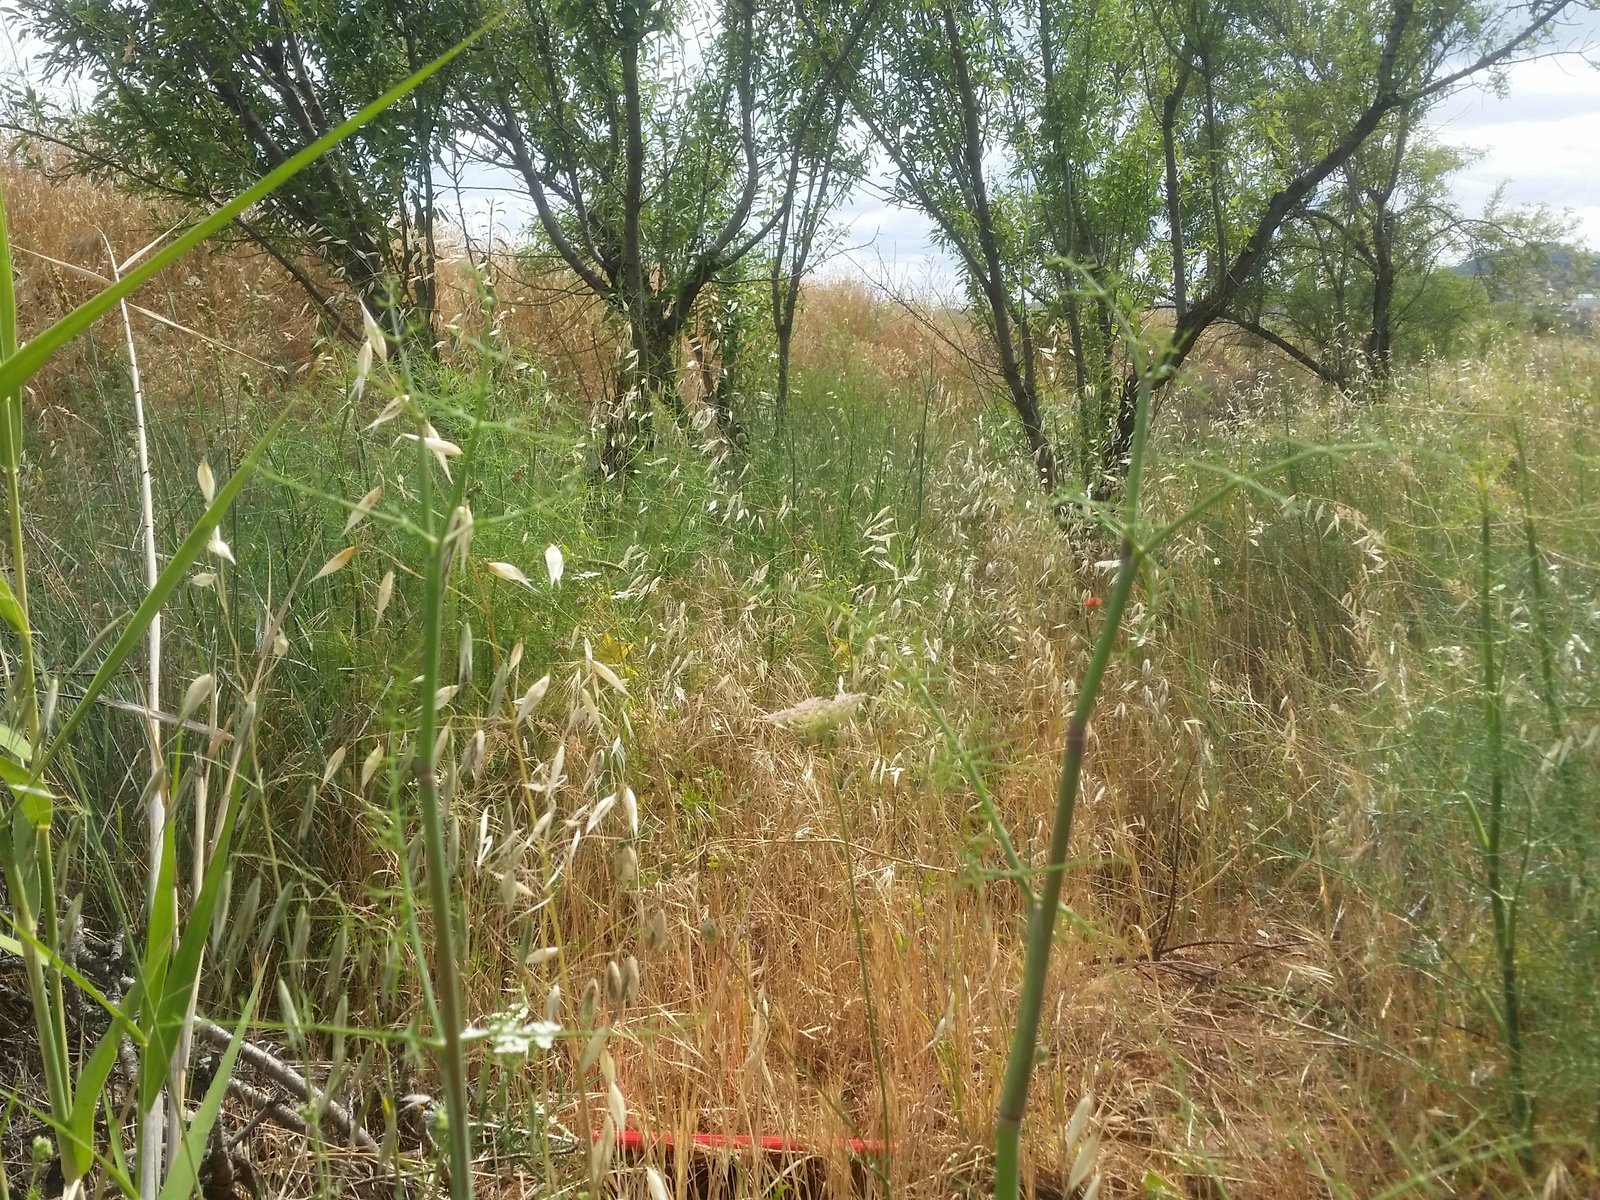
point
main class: Cropland
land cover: Nuts trees
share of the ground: 50 - 75 %
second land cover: Grassland without tree/shrub cover
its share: > 75 %
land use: Abandoned areas
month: June
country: ES
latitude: 38.7021
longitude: -2.5935
